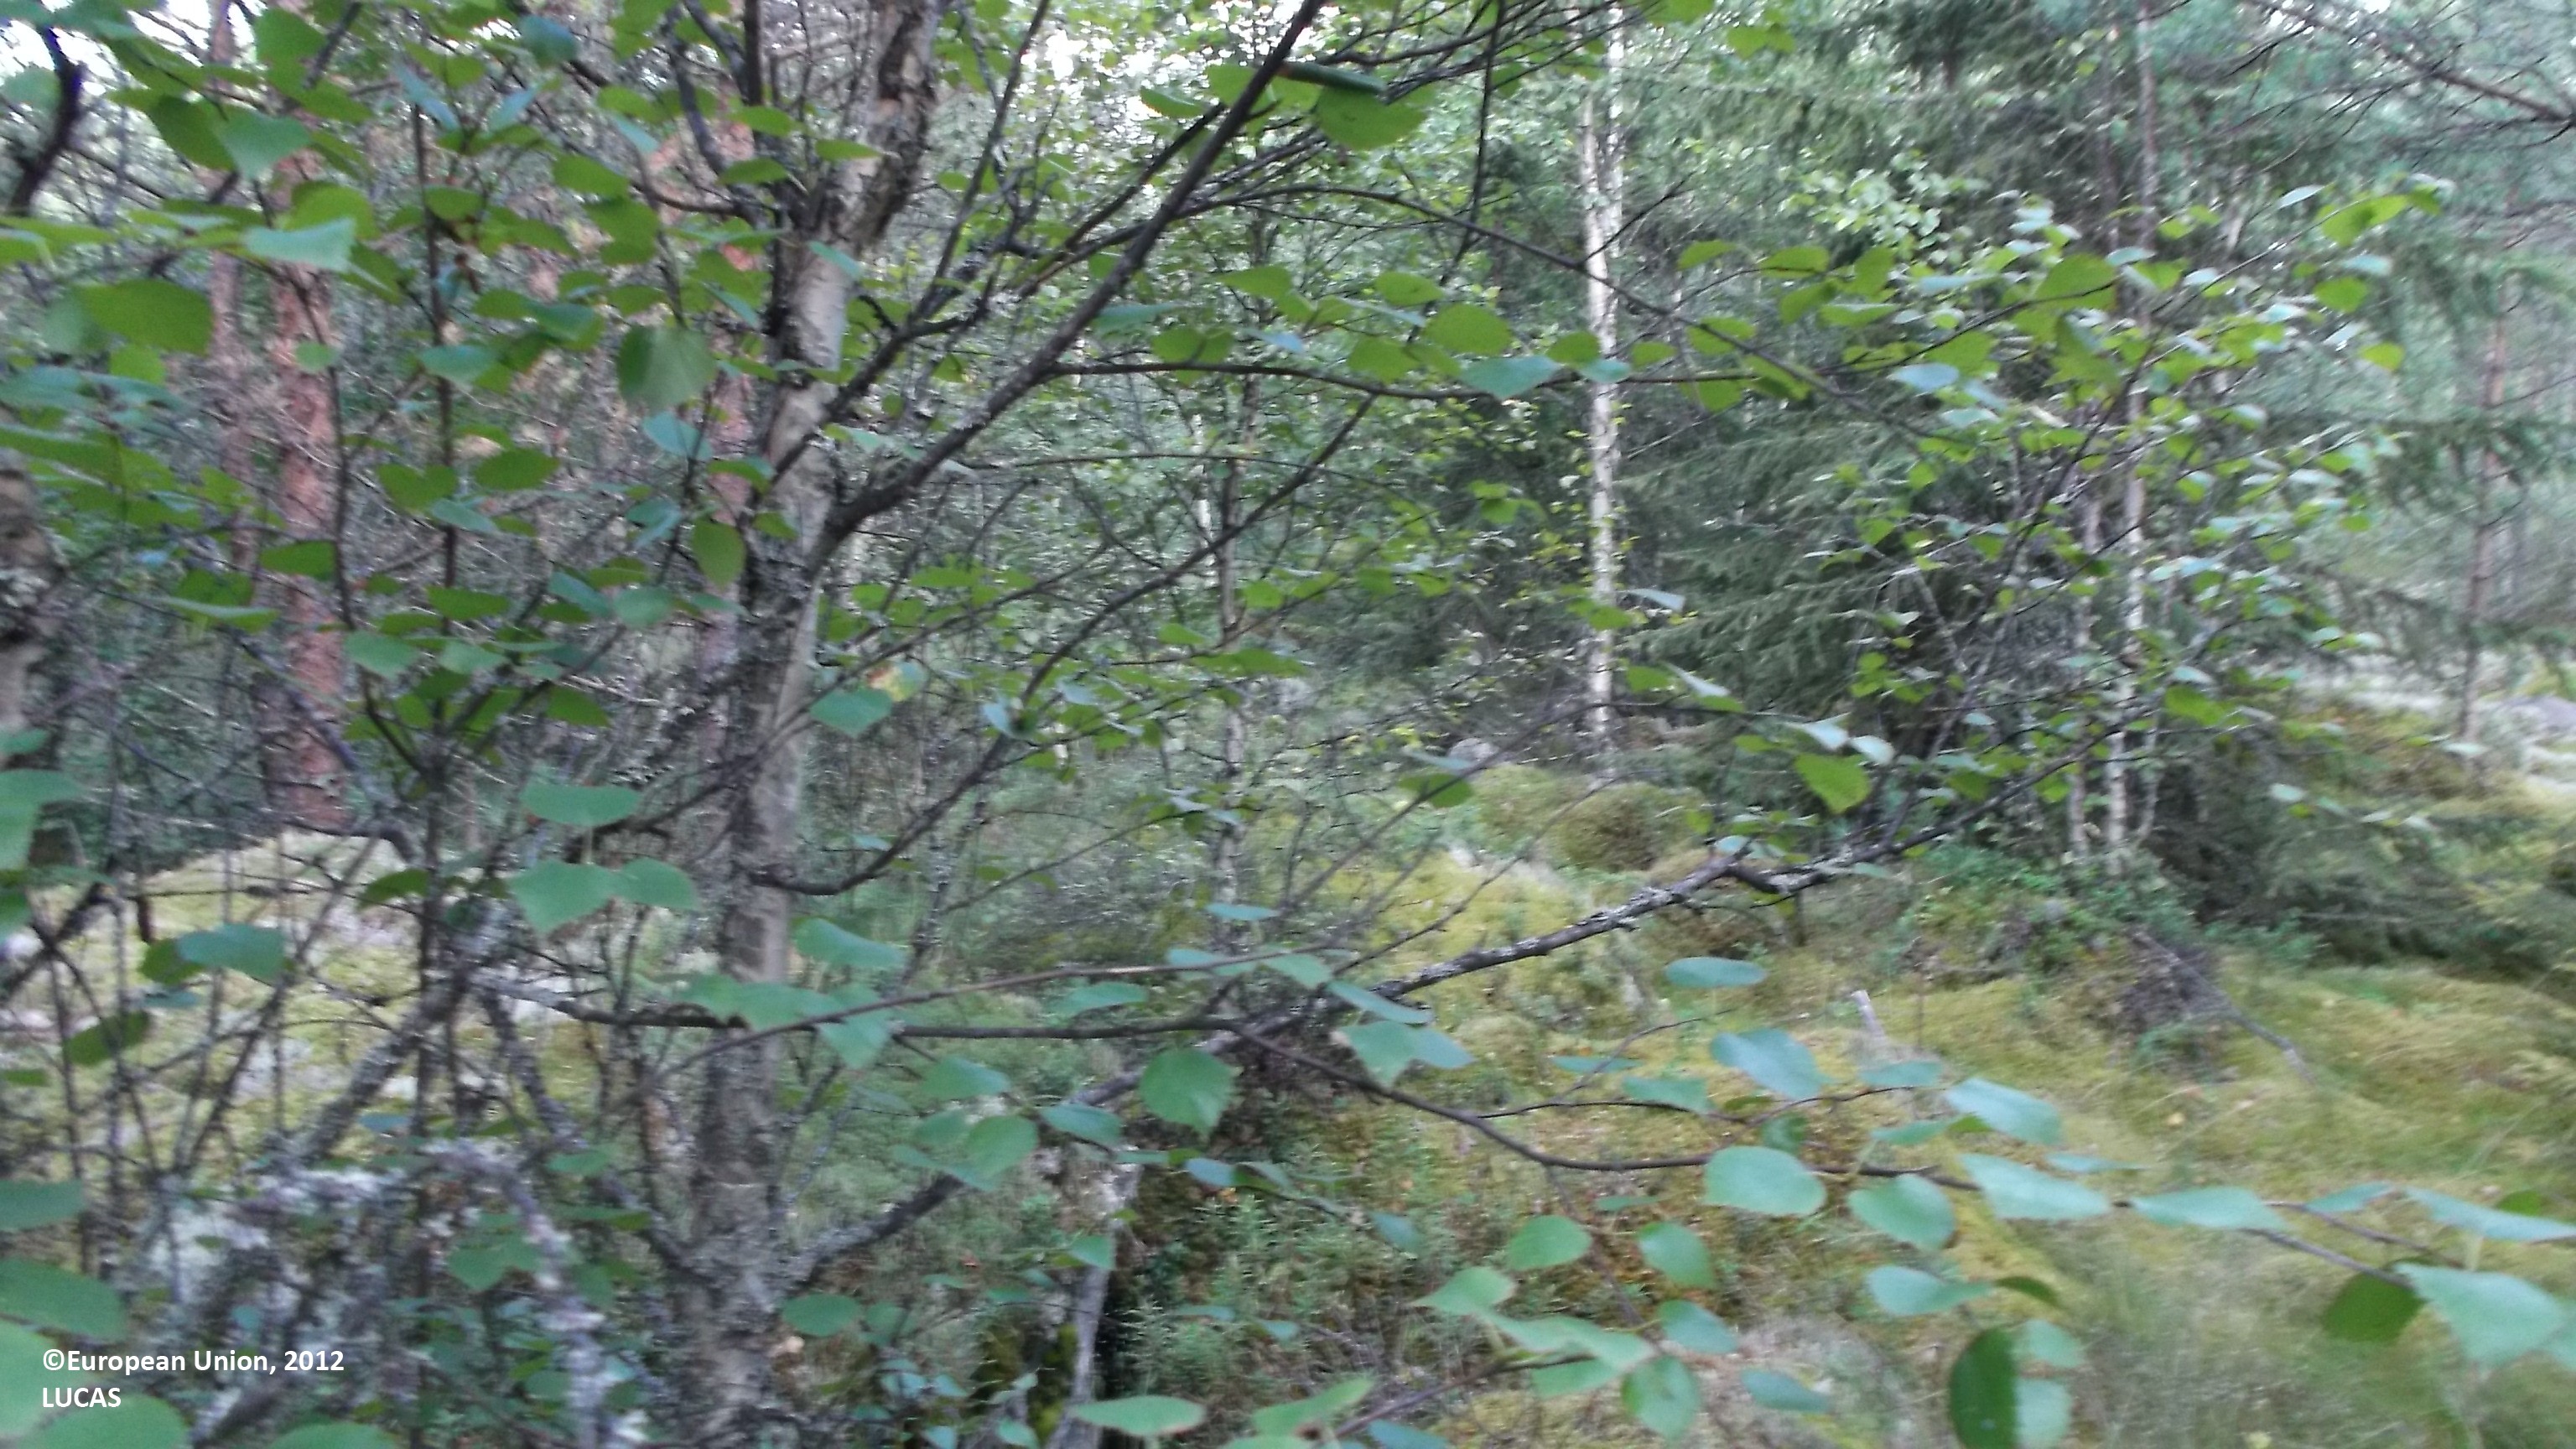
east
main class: Woodland
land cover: Pine dominated mixed woodland
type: boreal forest
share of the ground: 50 - 75 %
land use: Forestry
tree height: > 5 m
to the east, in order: Pine dominated mixed woodland; Other mixed woodland; Ditches and canals; Pine dominated mixed woodland; Tracks; Pine dominated mixed woodland; Tracks; Other mixed woodland; Ditches and canals; Other mixed woodland; Rocks and stones
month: August
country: FI
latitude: 63.9640
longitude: 23.7217
